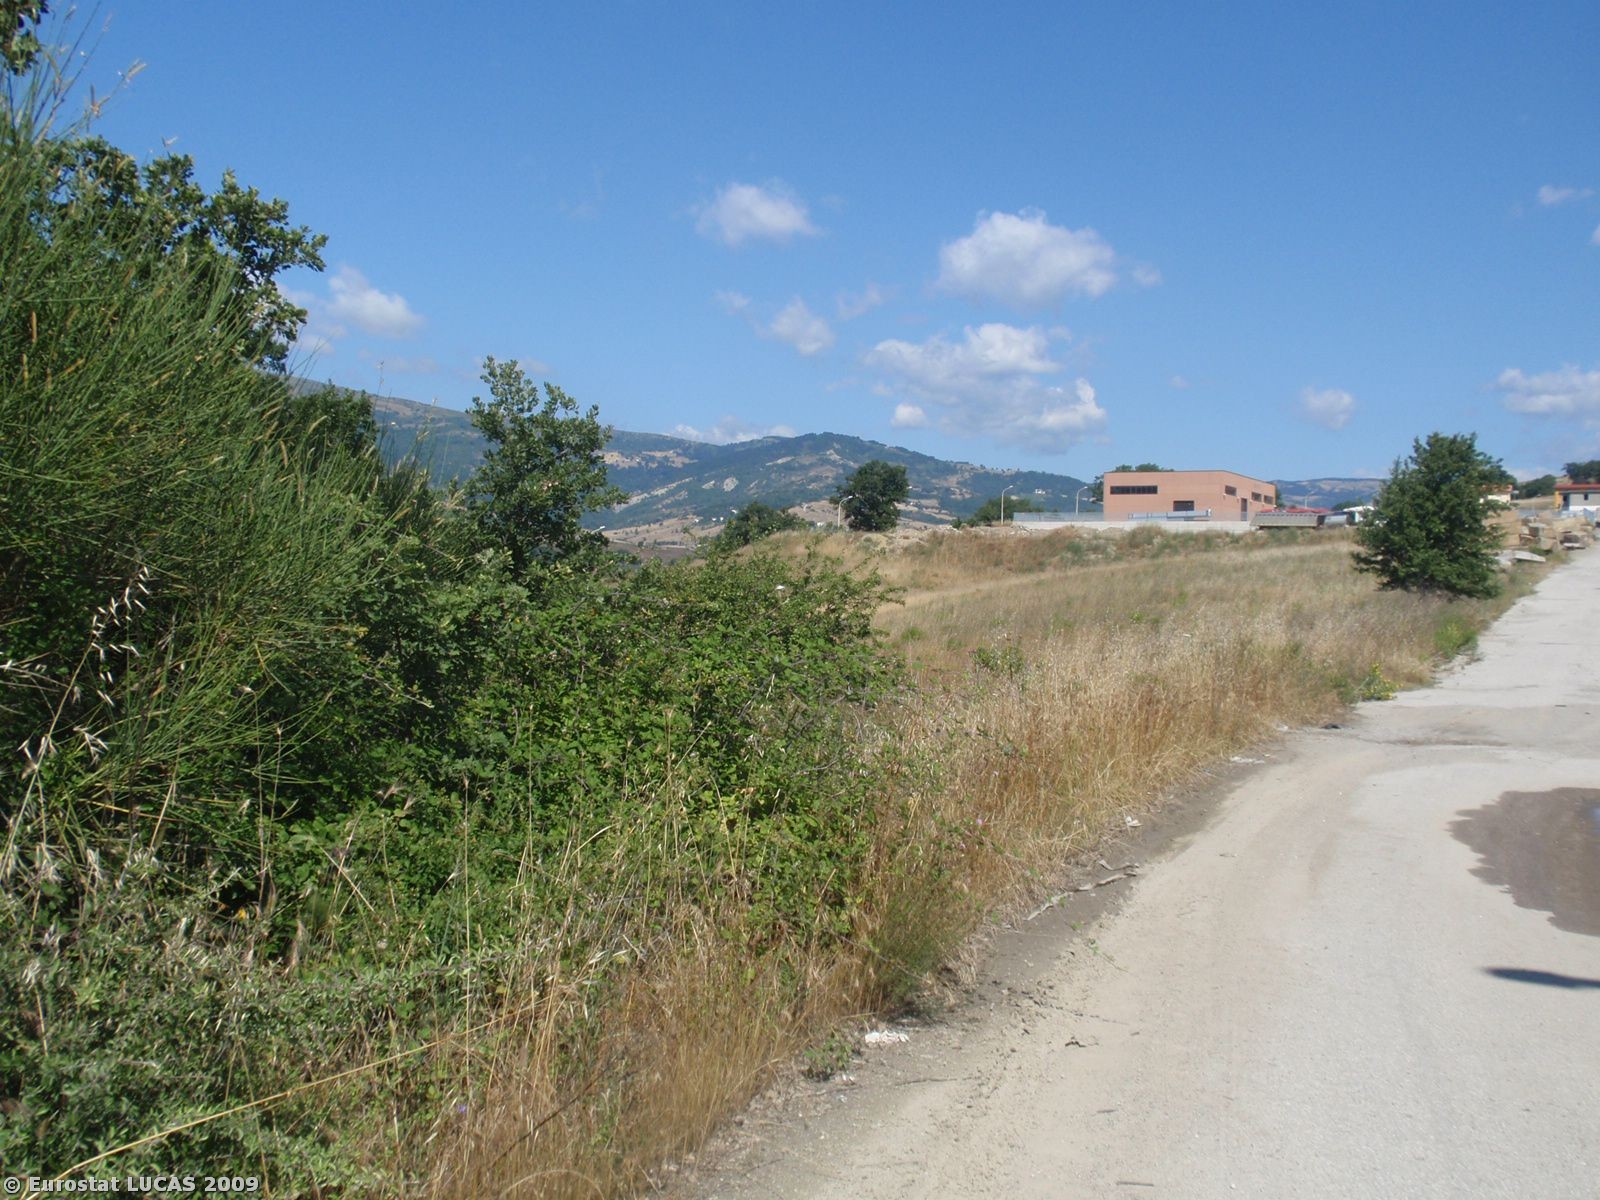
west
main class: Shrubland
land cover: Shrubland with sparse tree cover
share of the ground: > 75 %
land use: Unused
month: June
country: IT
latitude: 40.3504
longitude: 16.0862
